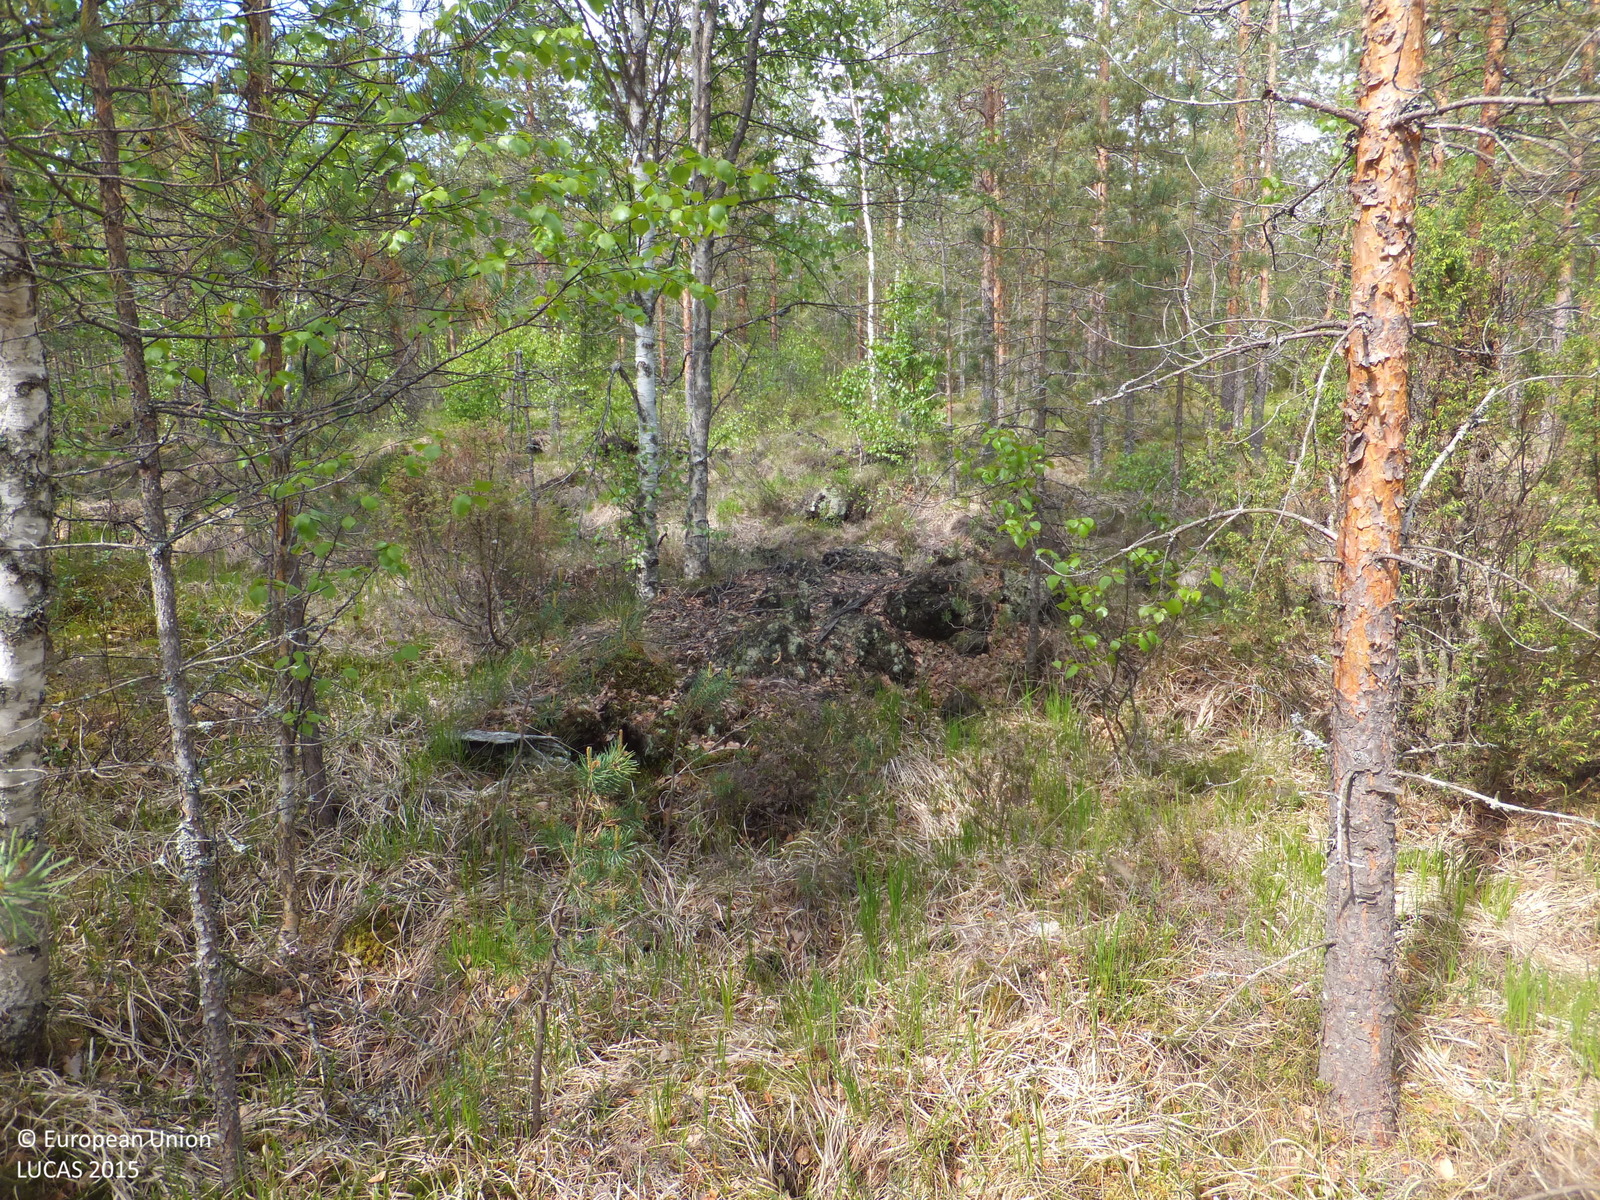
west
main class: Woodland
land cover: Pine dominated mixed woodland
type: boreal forest
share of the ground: 50 - 75 %
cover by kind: coniferous forest trees 30 %, broadleaved forest trees 30 %, herbaceous plants 15 %, lichens and mosses 15 %, shrubs 10 %
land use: Forestry
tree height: > 5 m
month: June
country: FI
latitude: 63.5906
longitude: 24.7751
